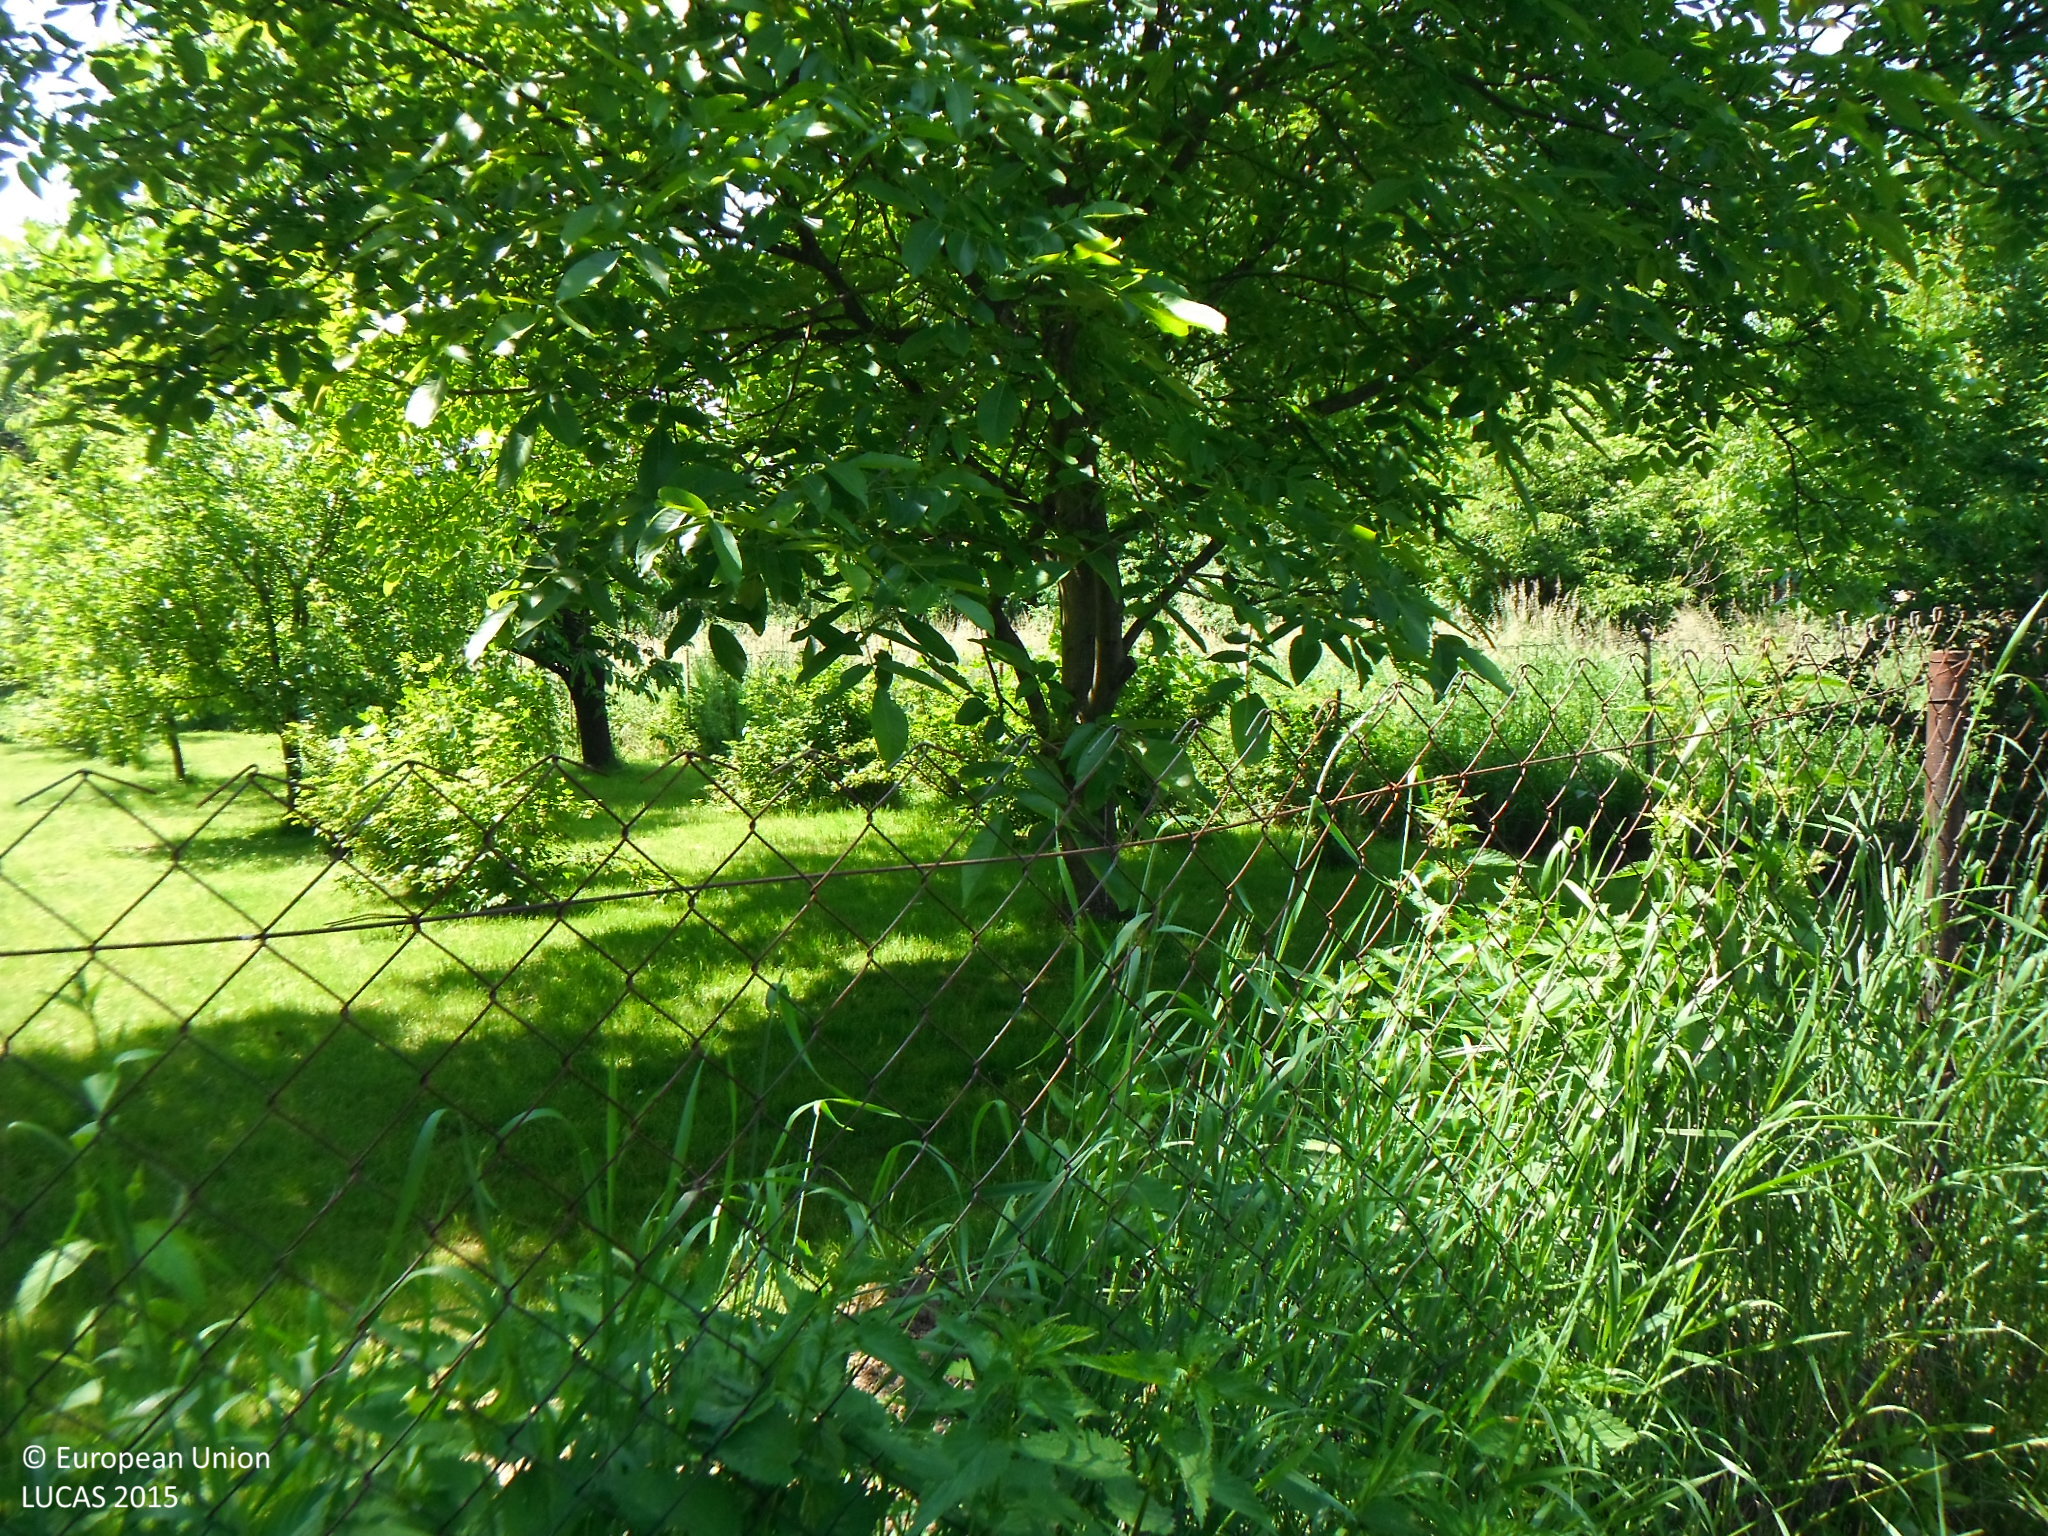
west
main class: Cropland
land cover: Nuts trees
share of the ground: > 75 %
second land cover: Grassland without tree/shrub cover
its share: > 75 %
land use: Kitchen garden
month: June
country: SK
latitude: 48.9932
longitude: 21.5707
